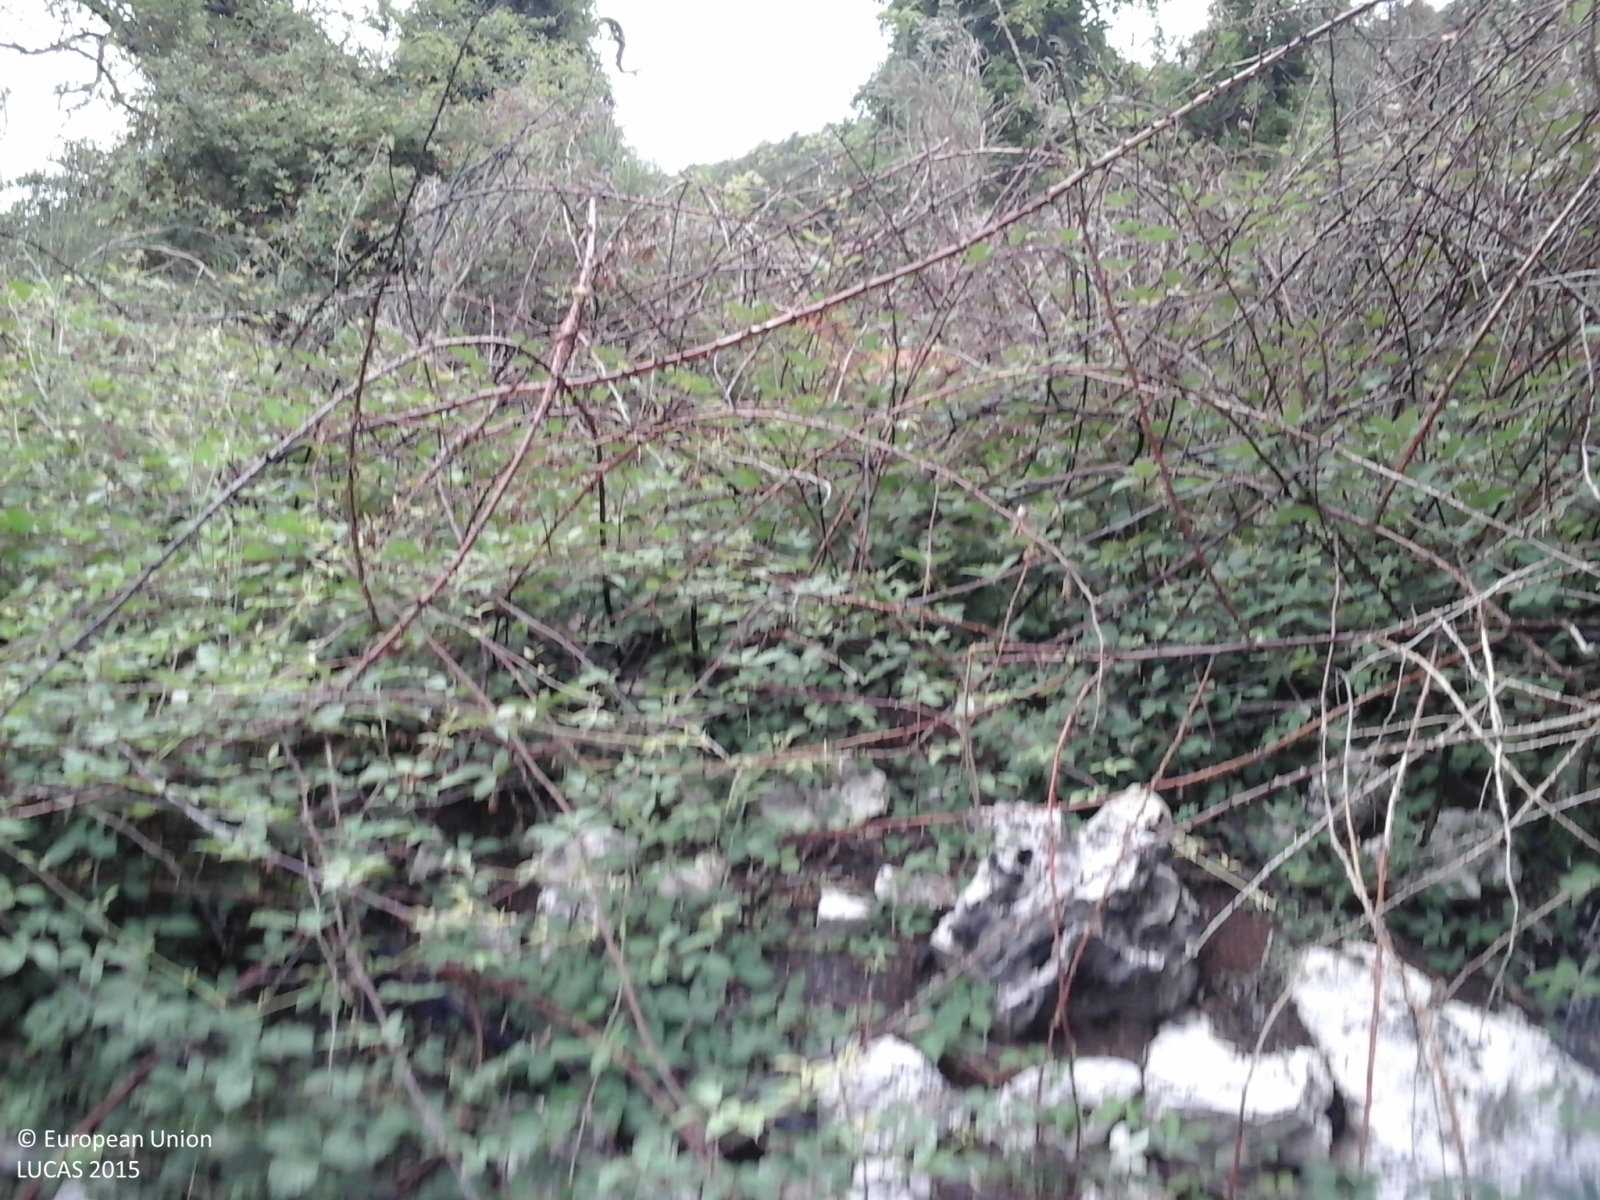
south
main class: Woodland
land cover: Broadleaved woodland
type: thermophilous deciduous forest
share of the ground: > 75 %
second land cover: Grassland without tree/shrub cover
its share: > 75 %
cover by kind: broadleaved forest trees 100 %
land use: Forestry
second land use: Agriculture (excluding fallow land and kitchen gardens)
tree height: < 5 m
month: July
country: IT
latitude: 41.5610
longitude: 12.9980
